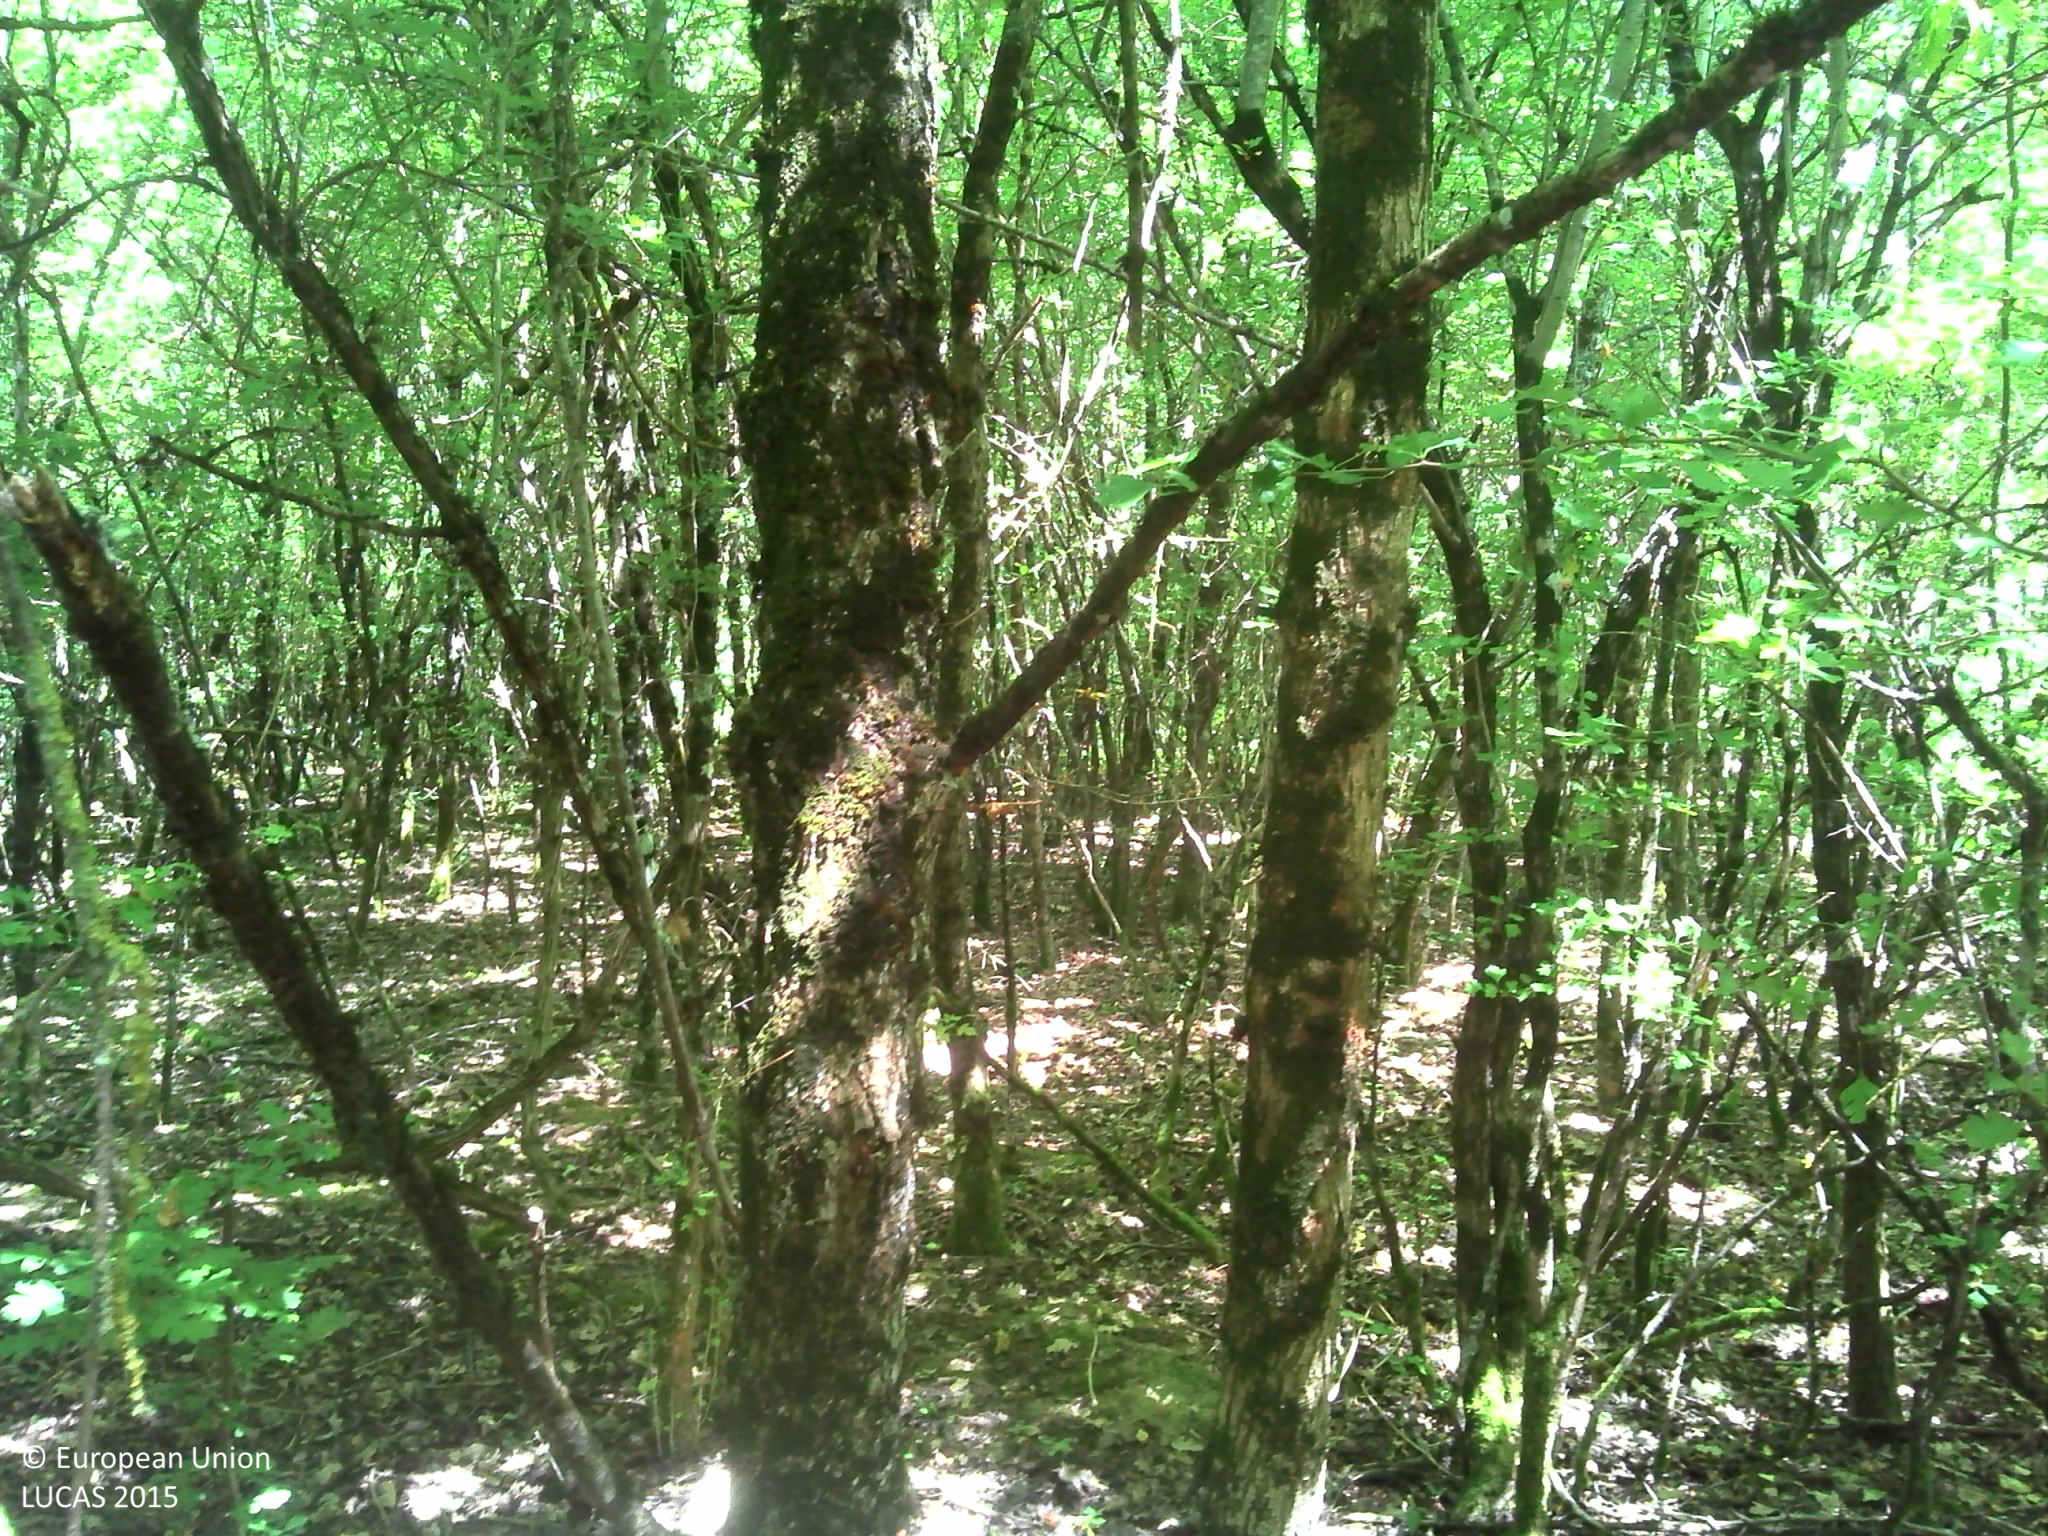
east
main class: Woodland
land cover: Broadleaved woodland
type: mesophytic deciduous forest
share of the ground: > 75 %
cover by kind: broadleaved forest trees 100 %
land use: Forestry
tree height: > 5 m
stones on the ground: < 10 %
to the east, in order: Broadleaved woodland; Tracks; Broadleaved woodland; Grassland without tree/shrub cover
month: June
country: FR
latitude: 43.6056
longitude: 1.9891
